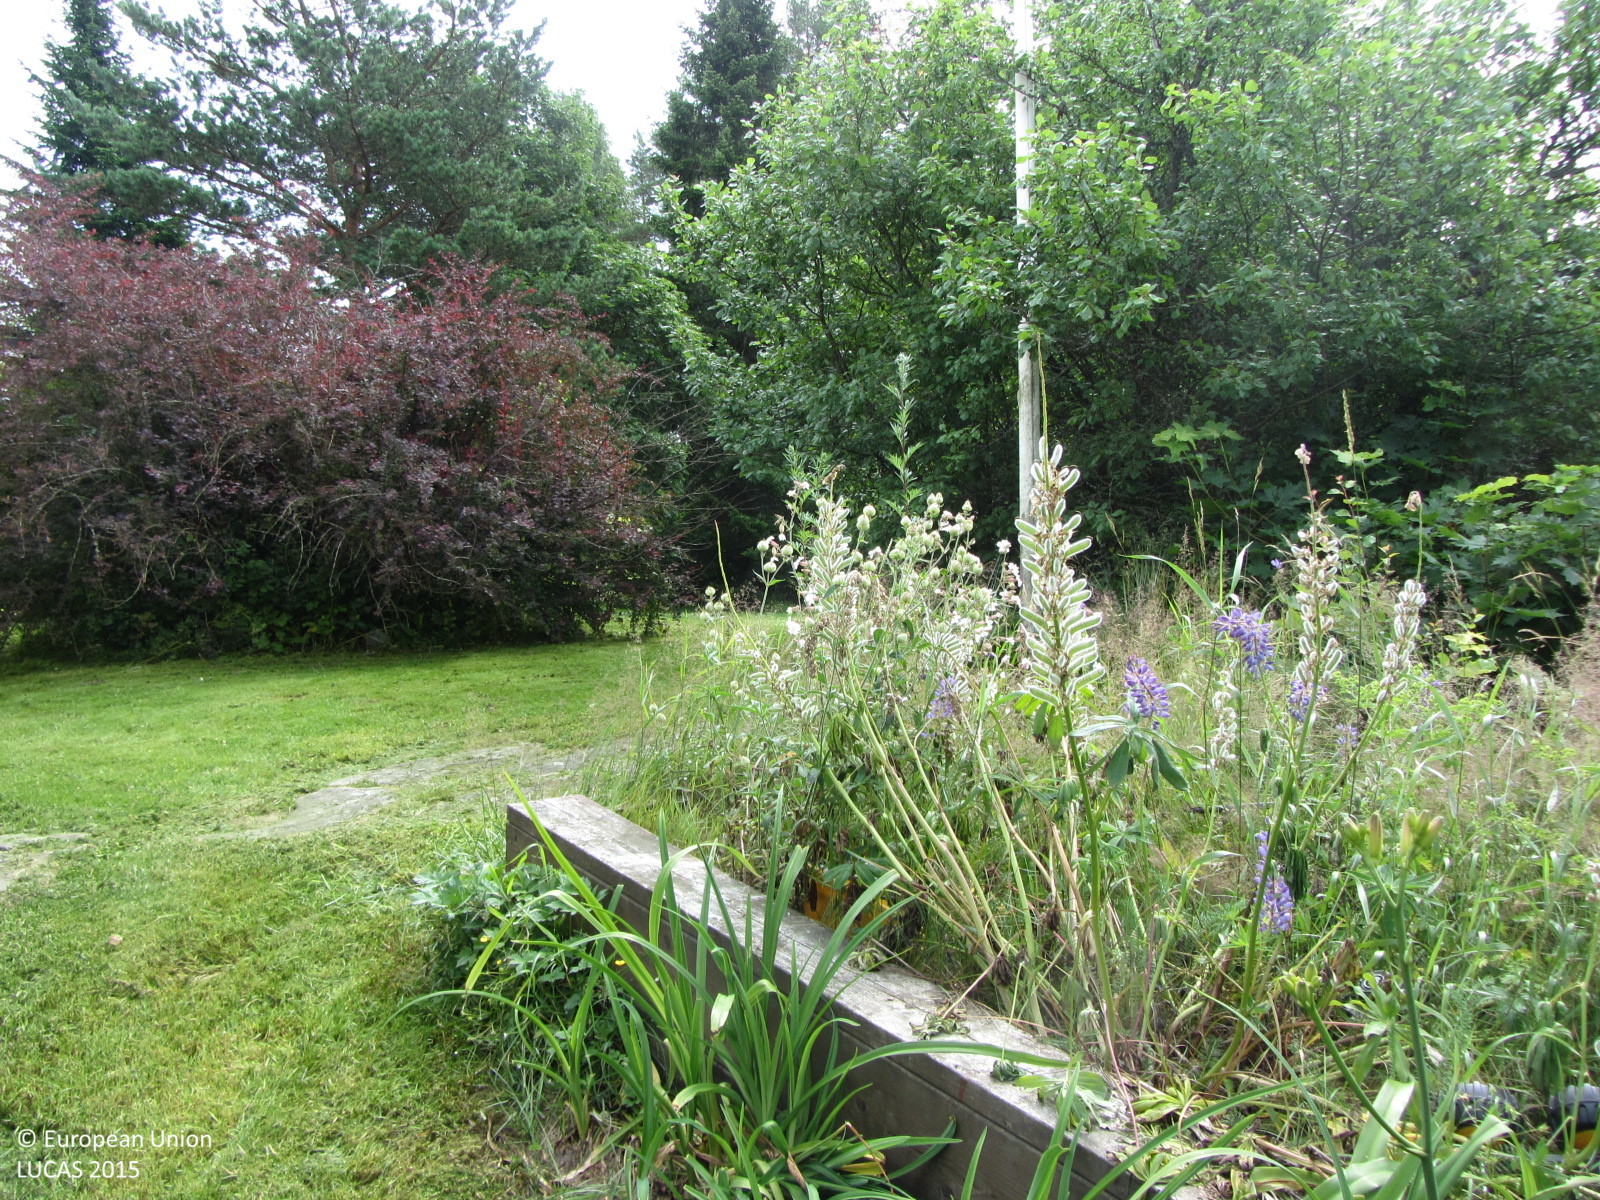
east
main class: Grassland
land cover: Grassland with sparse tree/shrub cover
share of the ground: > 75 %
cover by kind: herbaceous plants 85 %, shrubs 10 %, broadleaved forest trees 5 %
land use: Residential
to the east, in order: Grassland with sparse tree/shrub cover; Other mixed woodland; Tracks; Grassland without tree/shrub cover; Managed hedges; Ditches and canals; Grass margins; Paved roads, cycling and walking lanes; Grass margins; Ditches and canals; Rape and turnip rape; Grass margins; Ditches and canals; Grass margins; Common wheat
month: July
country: FI
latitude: 60.0724
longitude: 24.0992
